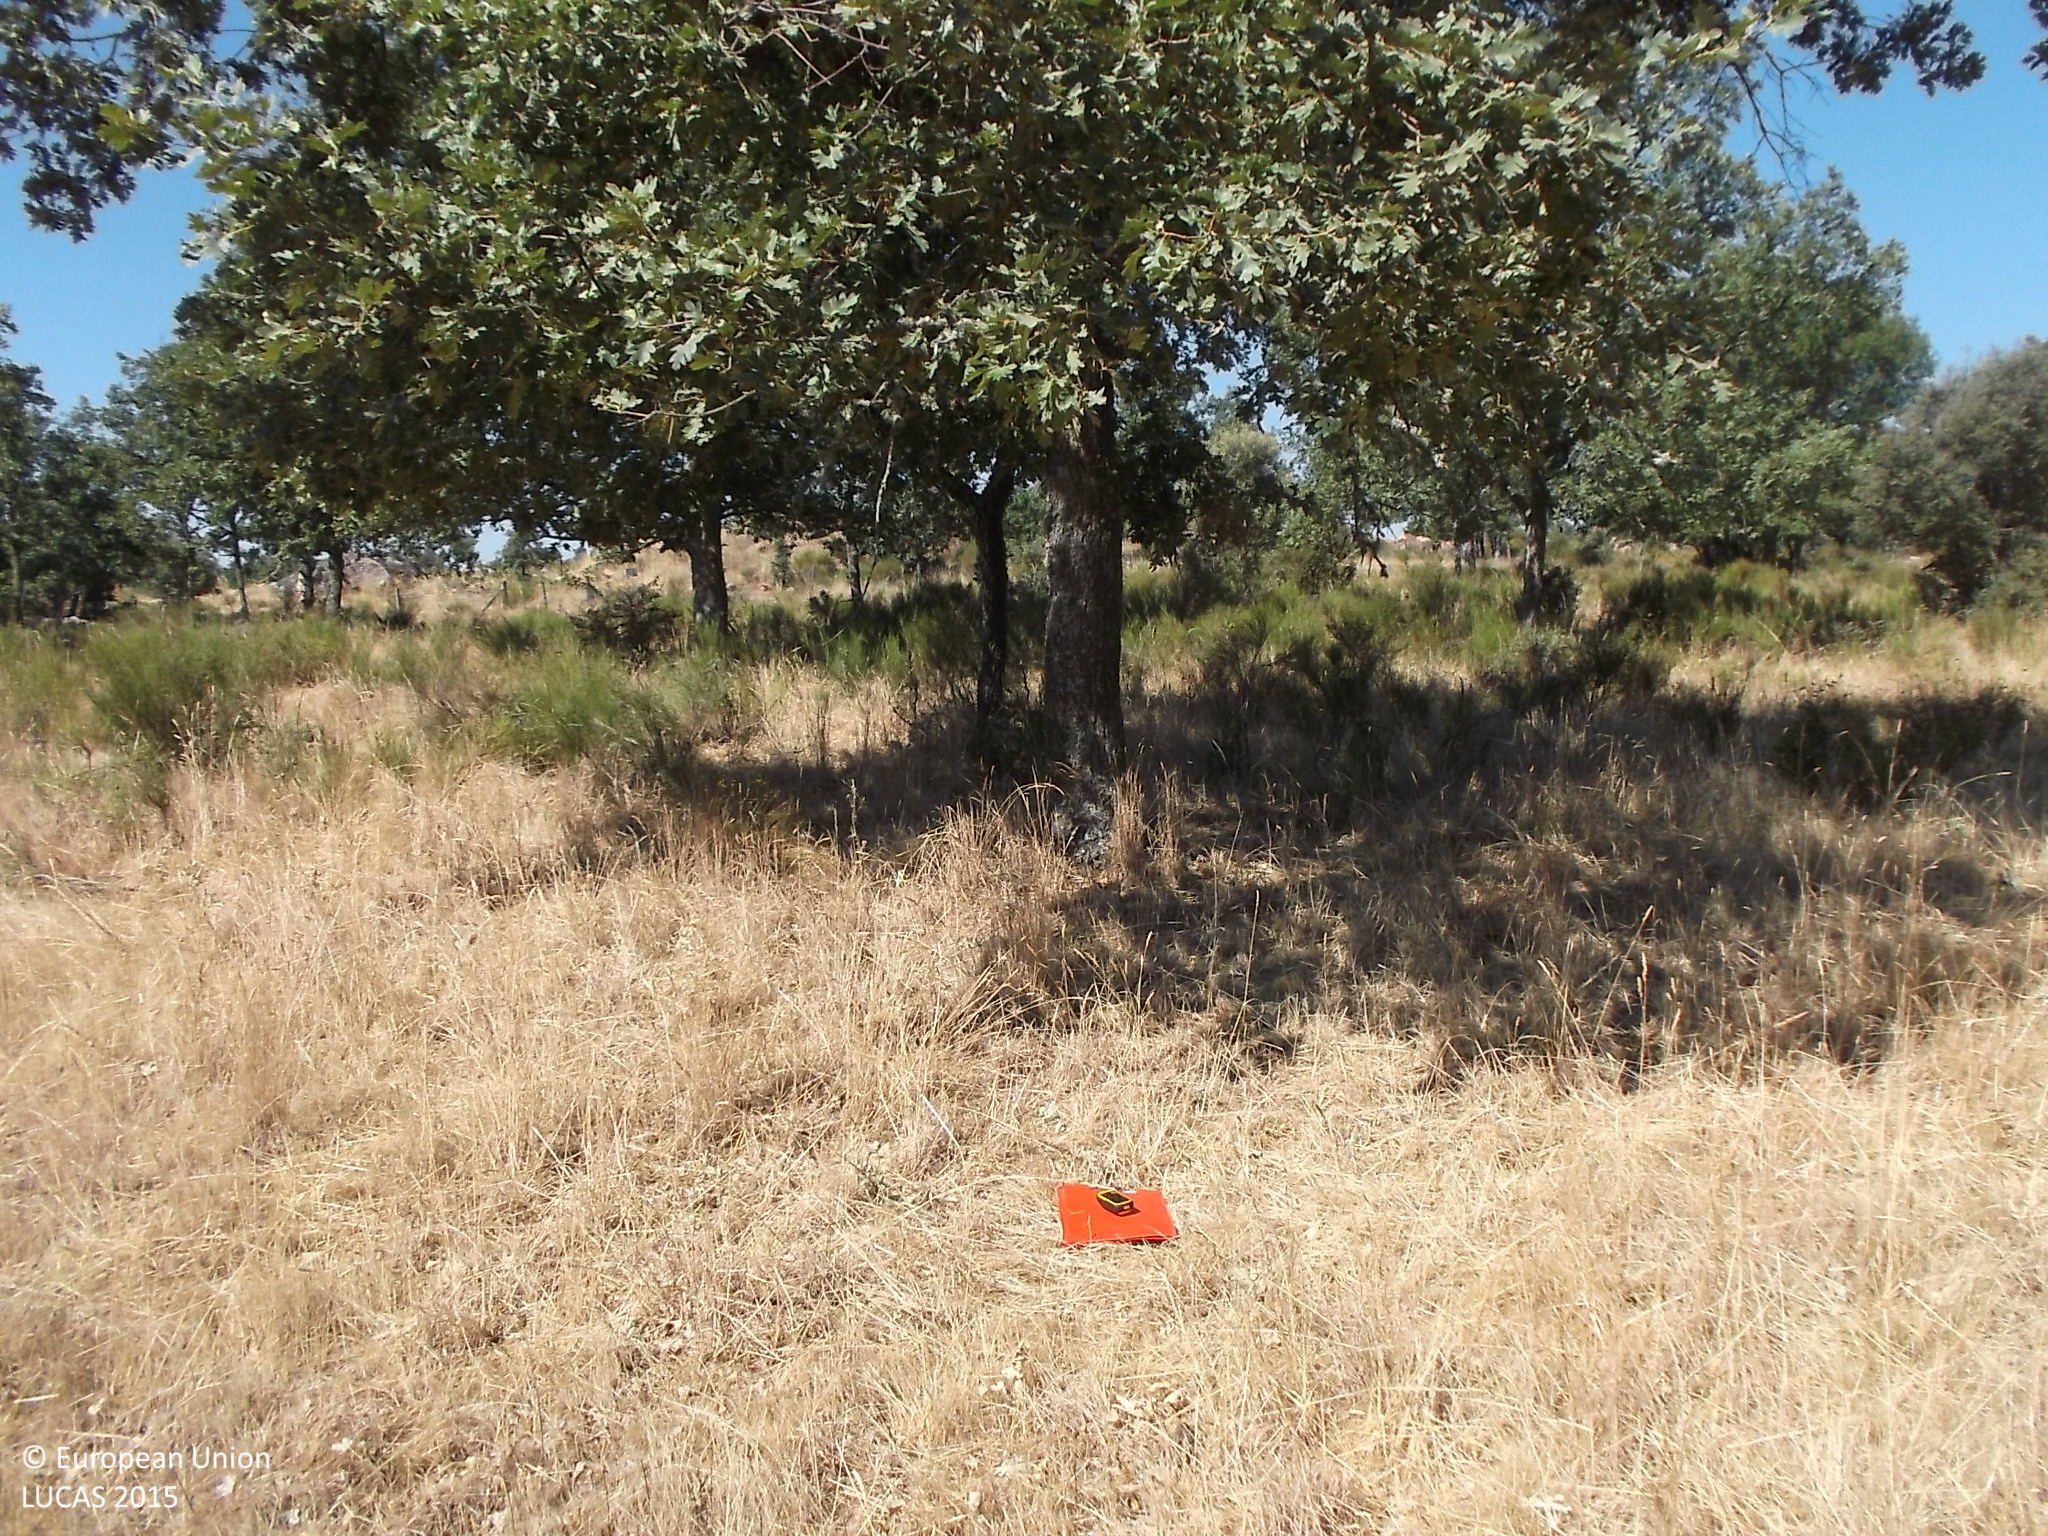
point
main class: Woodland
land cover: Broadleaved woodland
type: broadleaved evergreen forest
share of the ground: 10 - 25 %
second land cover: Shrubland without tree cover
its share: 25 - 50 %
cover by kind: shrubs 40 %, herbaceous plants 35 %, broadleaved forest trees 25 %
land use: Forestry
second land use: Agriculture (excluding fallow land and kitchen gardens)
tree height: < 5 m
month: July
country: ES
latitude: 41.3543
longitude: -5.9987
